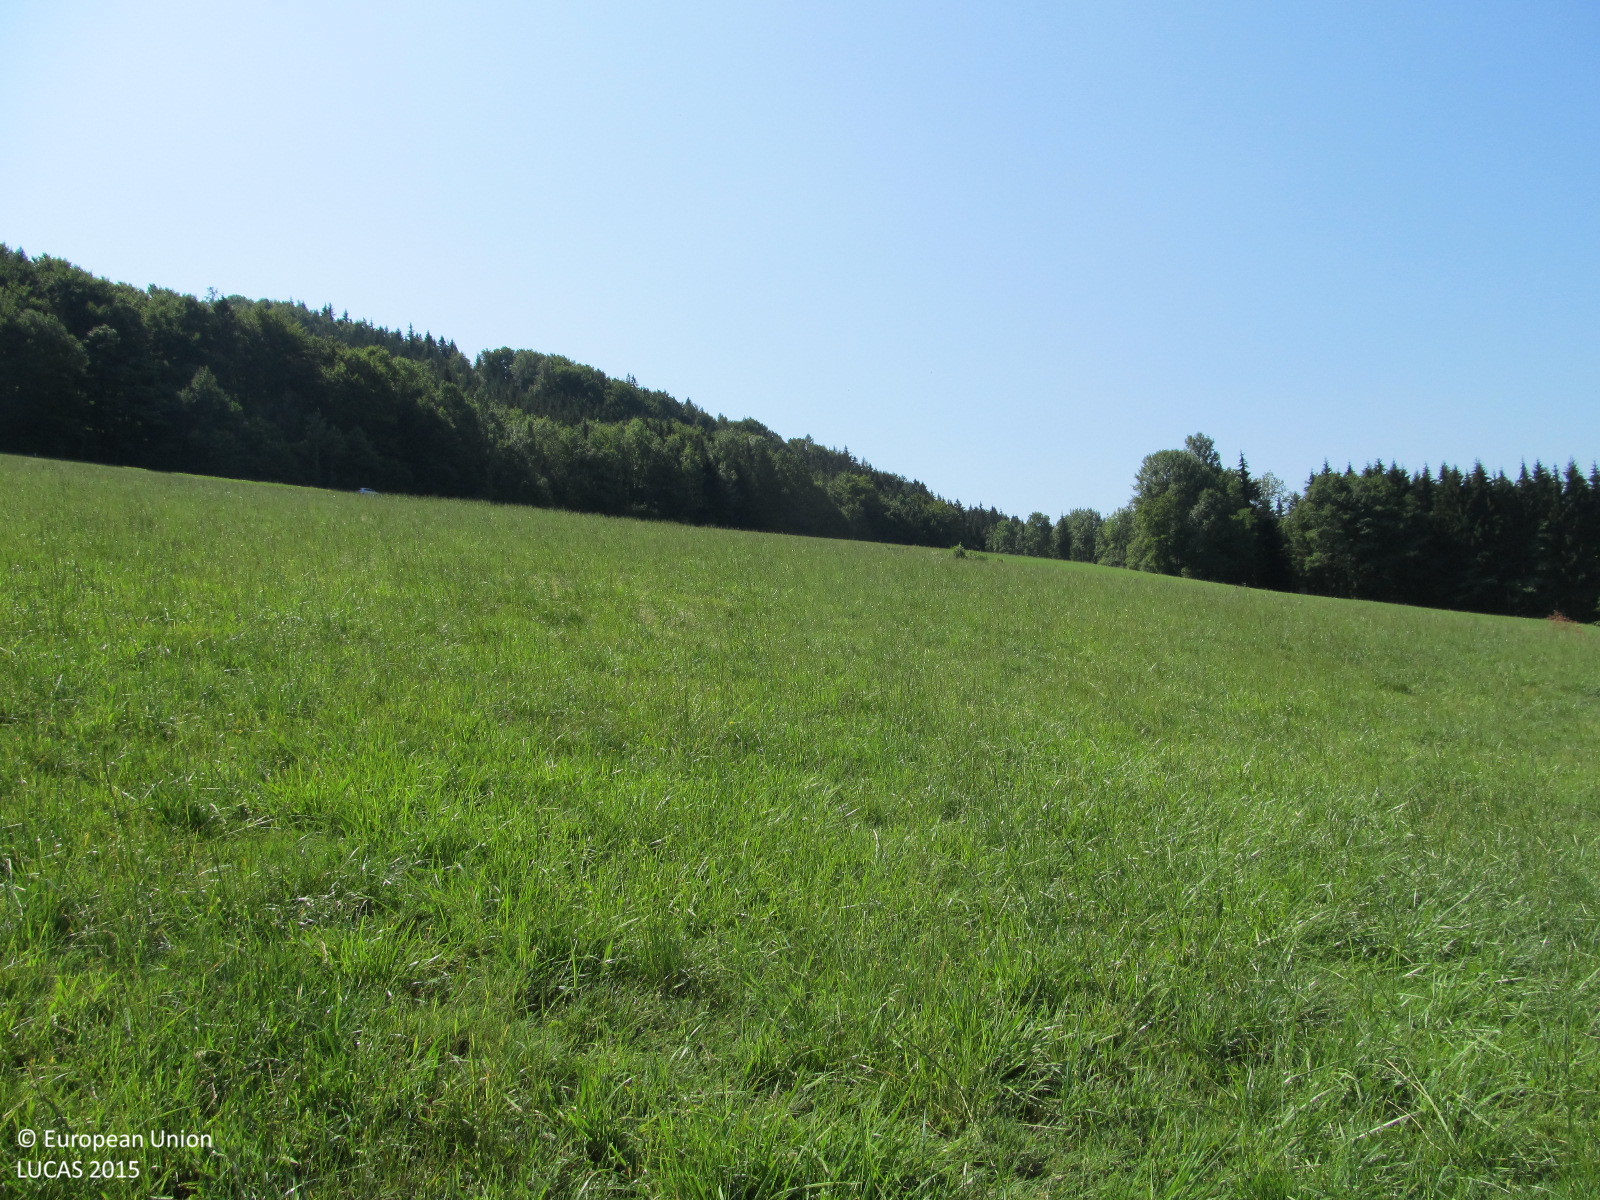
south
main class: Grassland
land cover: Grassland without tree/shrub cover
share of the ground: > 75 %
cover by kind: herbaceous plants 100 %
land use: Agriculture (excluding fallow land and kitchen gardens)
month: August
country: AT
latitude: 48.0729
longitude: 15.7606
